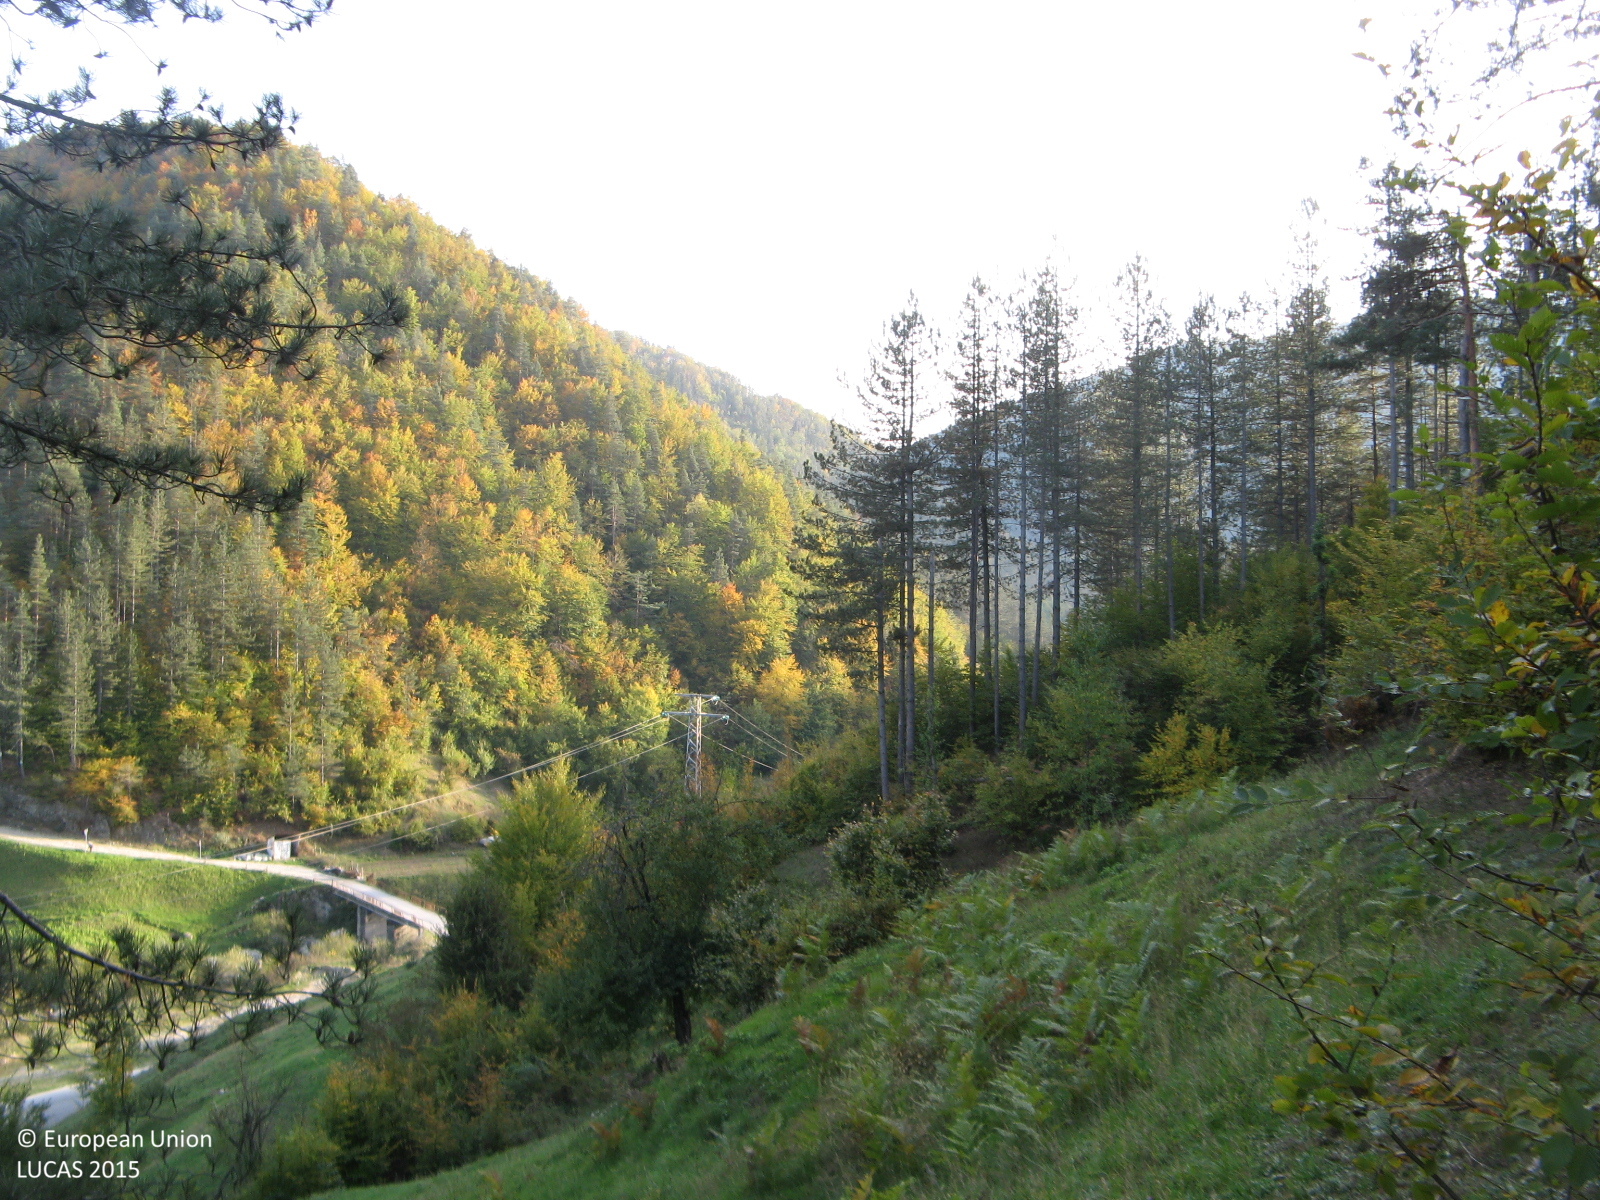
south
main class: Woodland
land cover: Pine dominated mixed woodland
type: hemiboreal forest and nemoral coniferous forest and mixed broadleaved-coniferous forest
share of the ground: > 75 %
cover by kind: coniferous forest trees 75 %, broadleaved forest trees 25 %
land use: Forestry
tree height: > 5 m
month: October
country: BG
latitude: 41.4600
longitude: 24.8545
